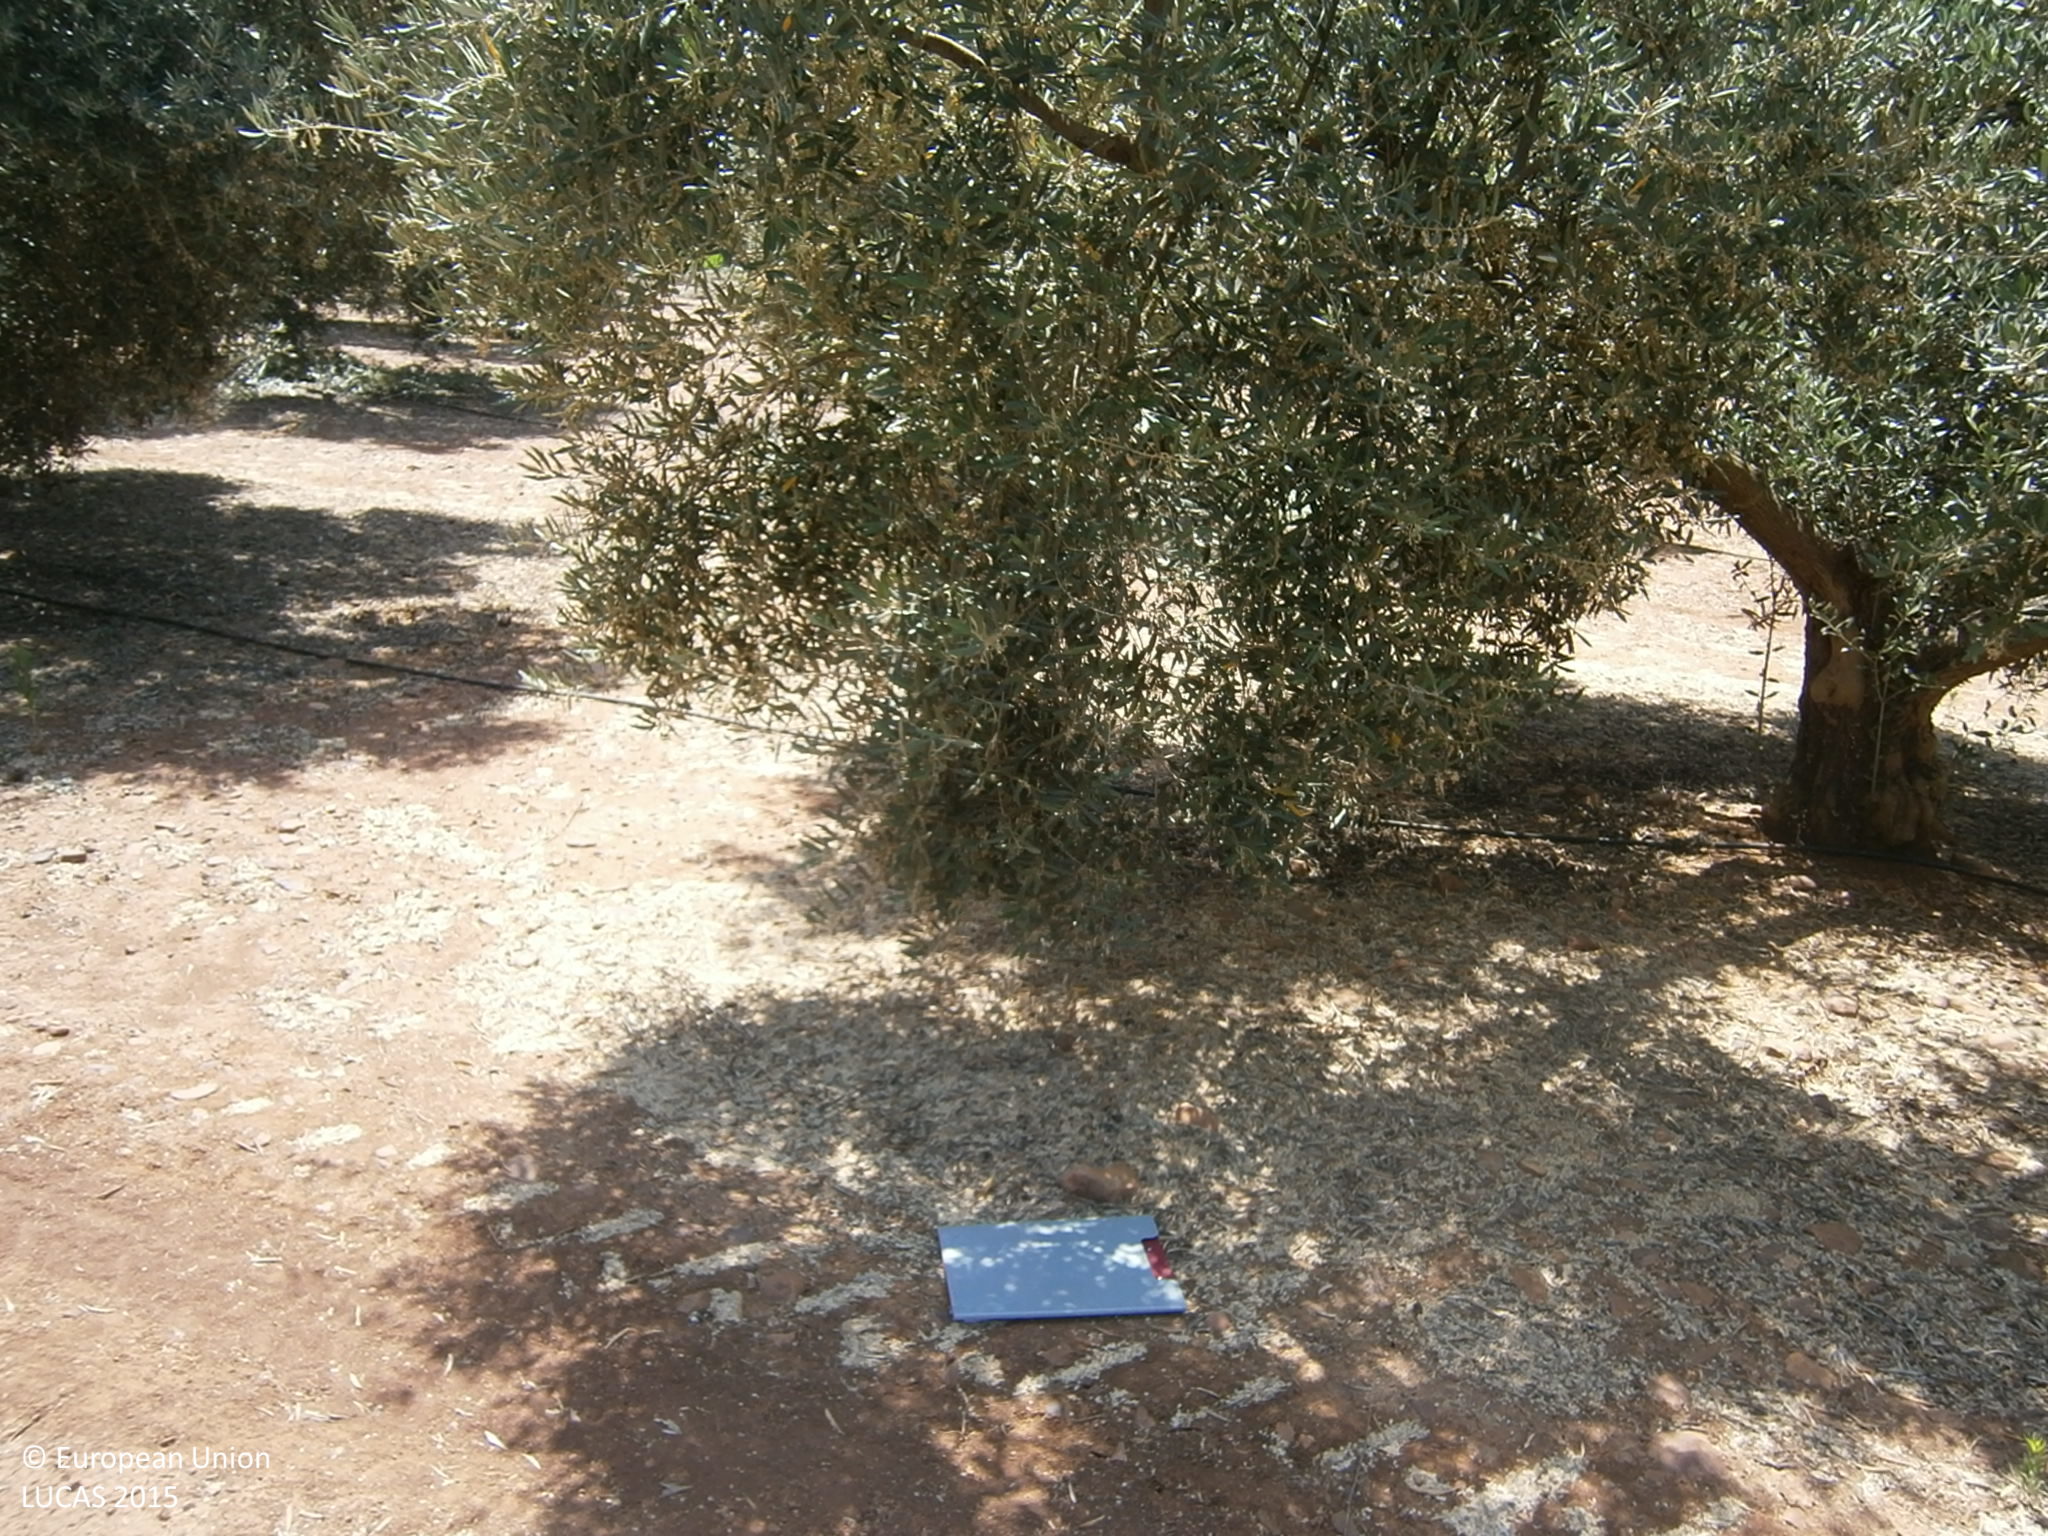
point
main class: Cropland
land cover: Olive groves
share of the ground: 50 - 75 %
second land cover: Spontaneously vegetated surfaces
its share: > 75 %
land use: Agriculture (excluding fallow land and kitchen gardens)
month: June
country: ES
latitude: 38.8344
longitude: -6.2162
